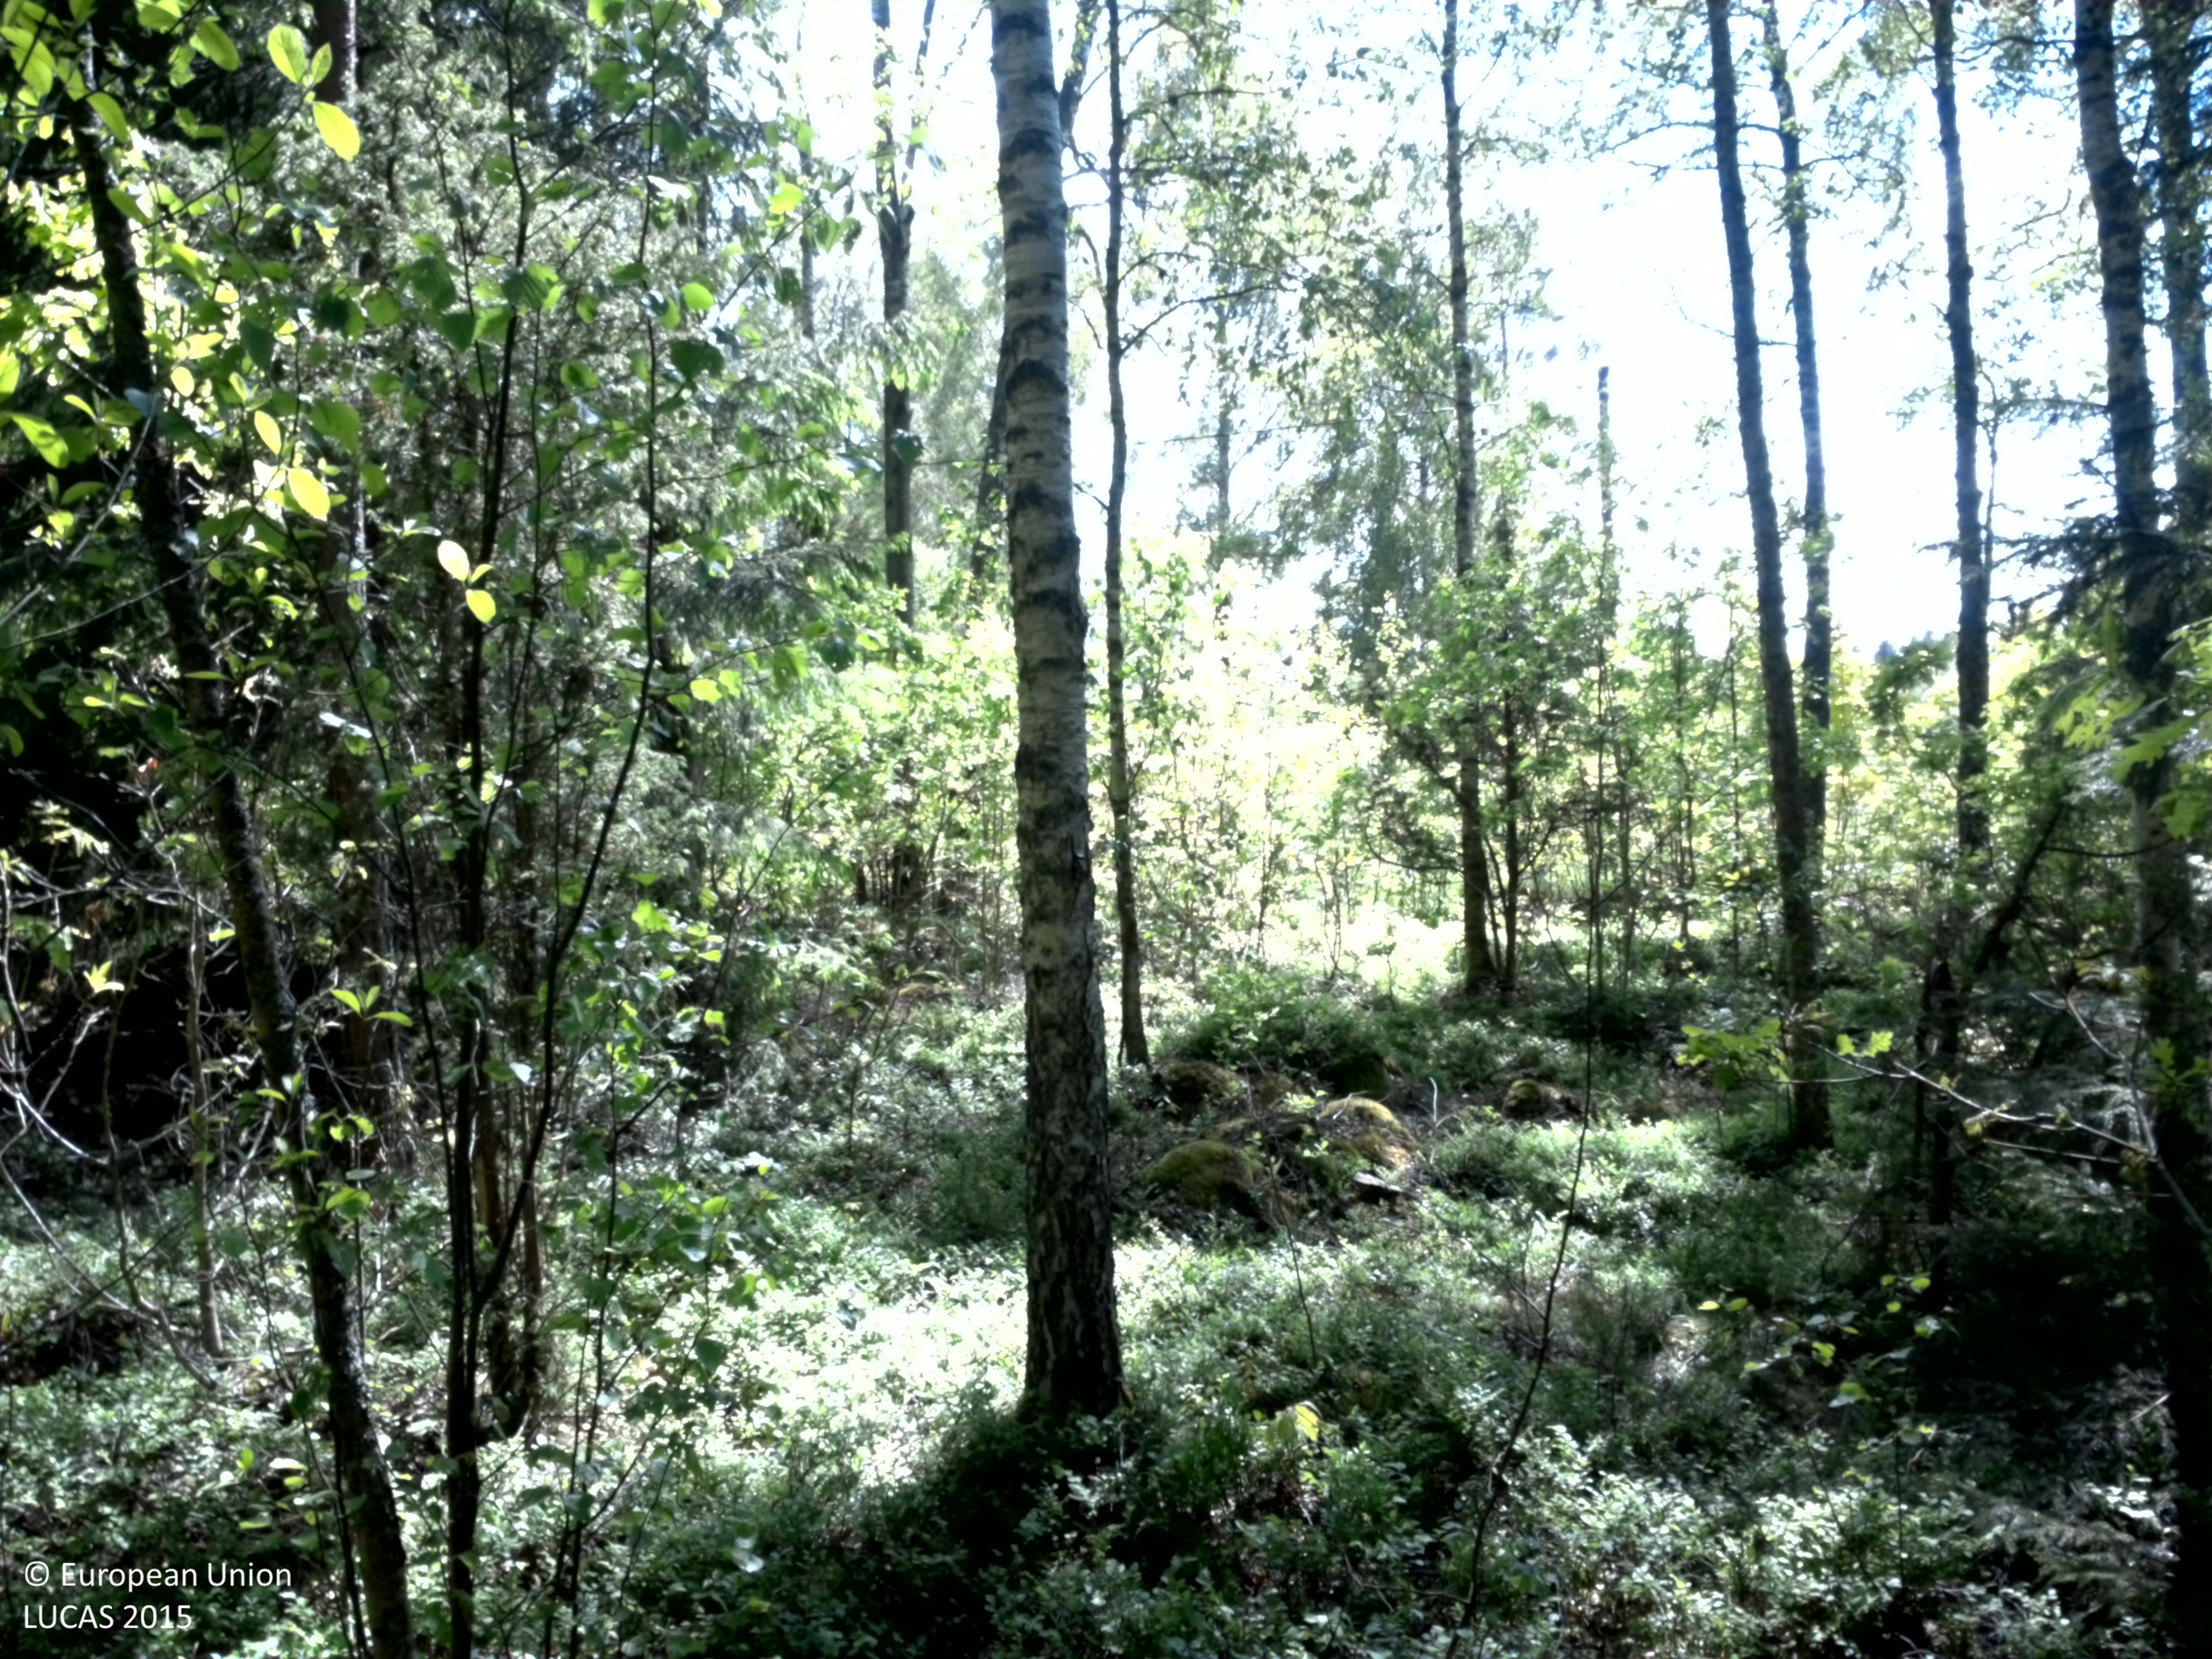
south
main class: Woodland
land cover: Spruce dominated mixed woodland
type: boreal forest
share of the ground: 50 - 75 %
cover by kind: broadleaved forest trees 40 %, coniferous forest trees 25 %, shrubs 20 %, lichens and mosses 10 %, herbaceous plants 5 %
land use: Forestry
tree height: > 5 m
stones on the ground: < 10 %
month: June
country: SE
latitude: 56.6596
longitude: 14.7122
